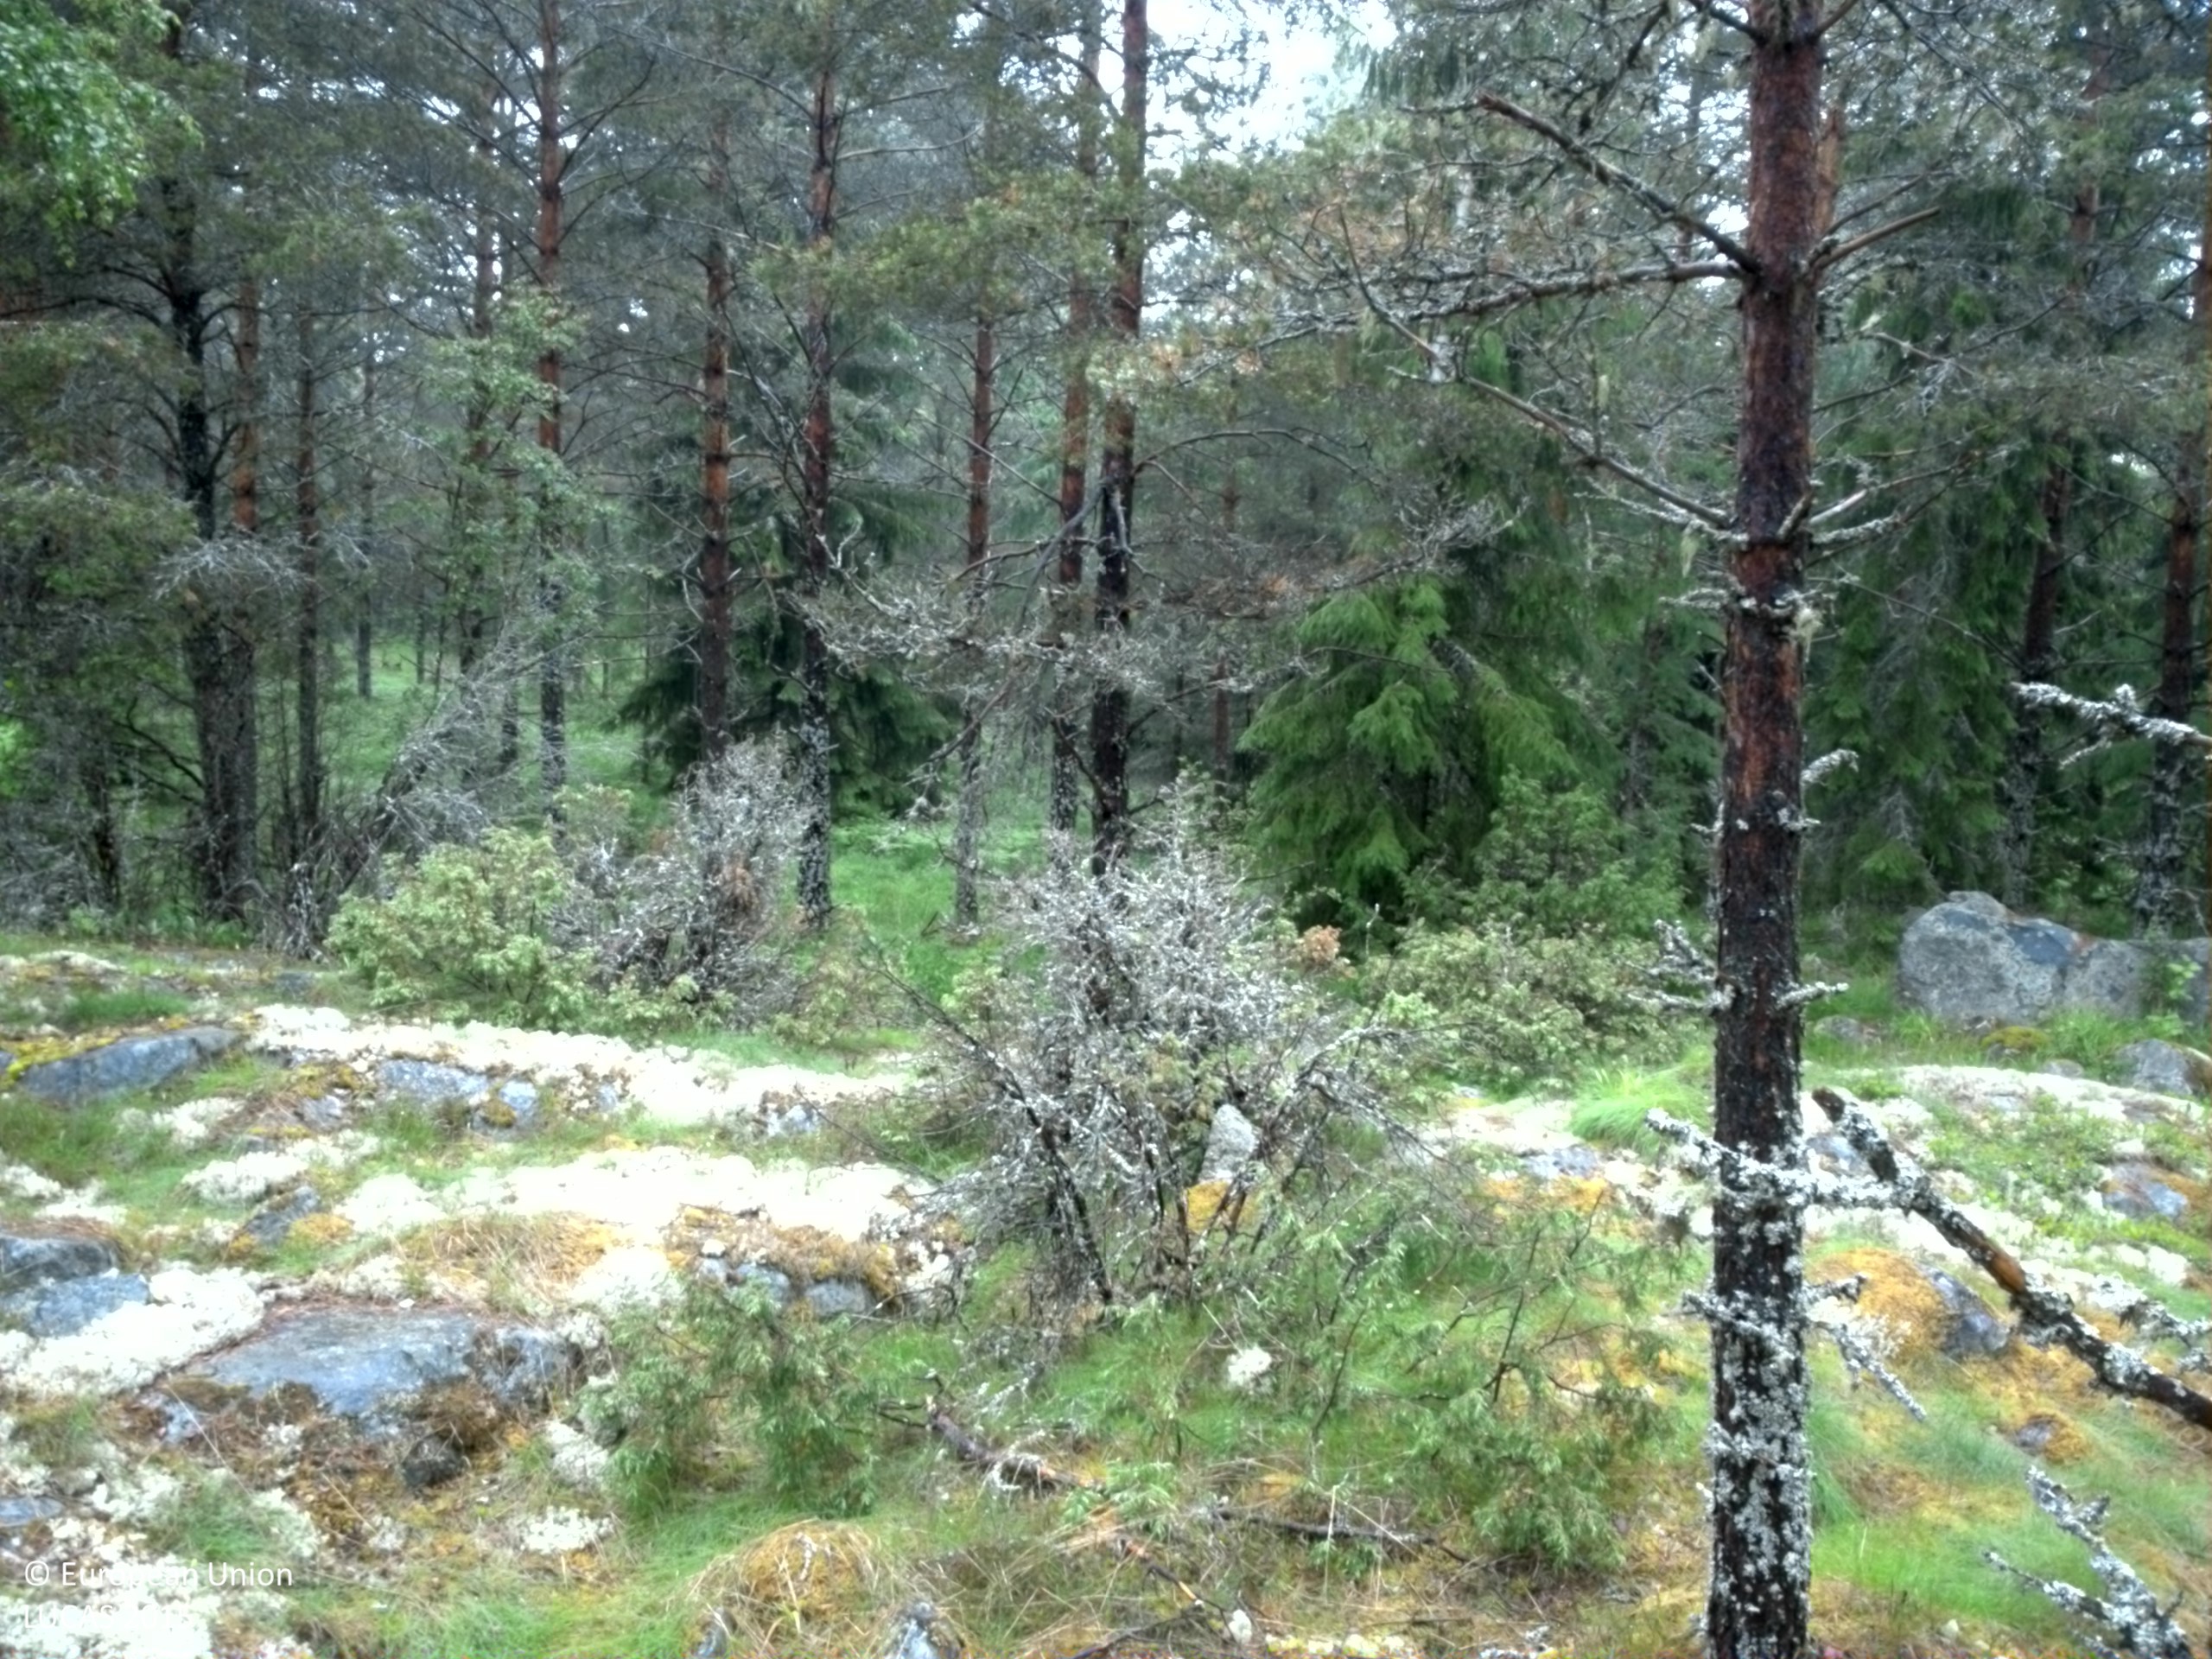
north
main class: Woodland
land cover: Pine dominated coniferous woodland
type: boreal forest
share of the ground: 50 - 75 %
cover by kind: coniferous forest trees 60 %, lichens and mosses 20 %, broadleaved forest trees 5 %, shrubs 5 %, herbaceous plants 5 %, consolidated bare surface 5 %
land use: Forestry
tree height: > 5 m
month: June
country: SE
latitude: 60.3643
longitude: 18.0978
